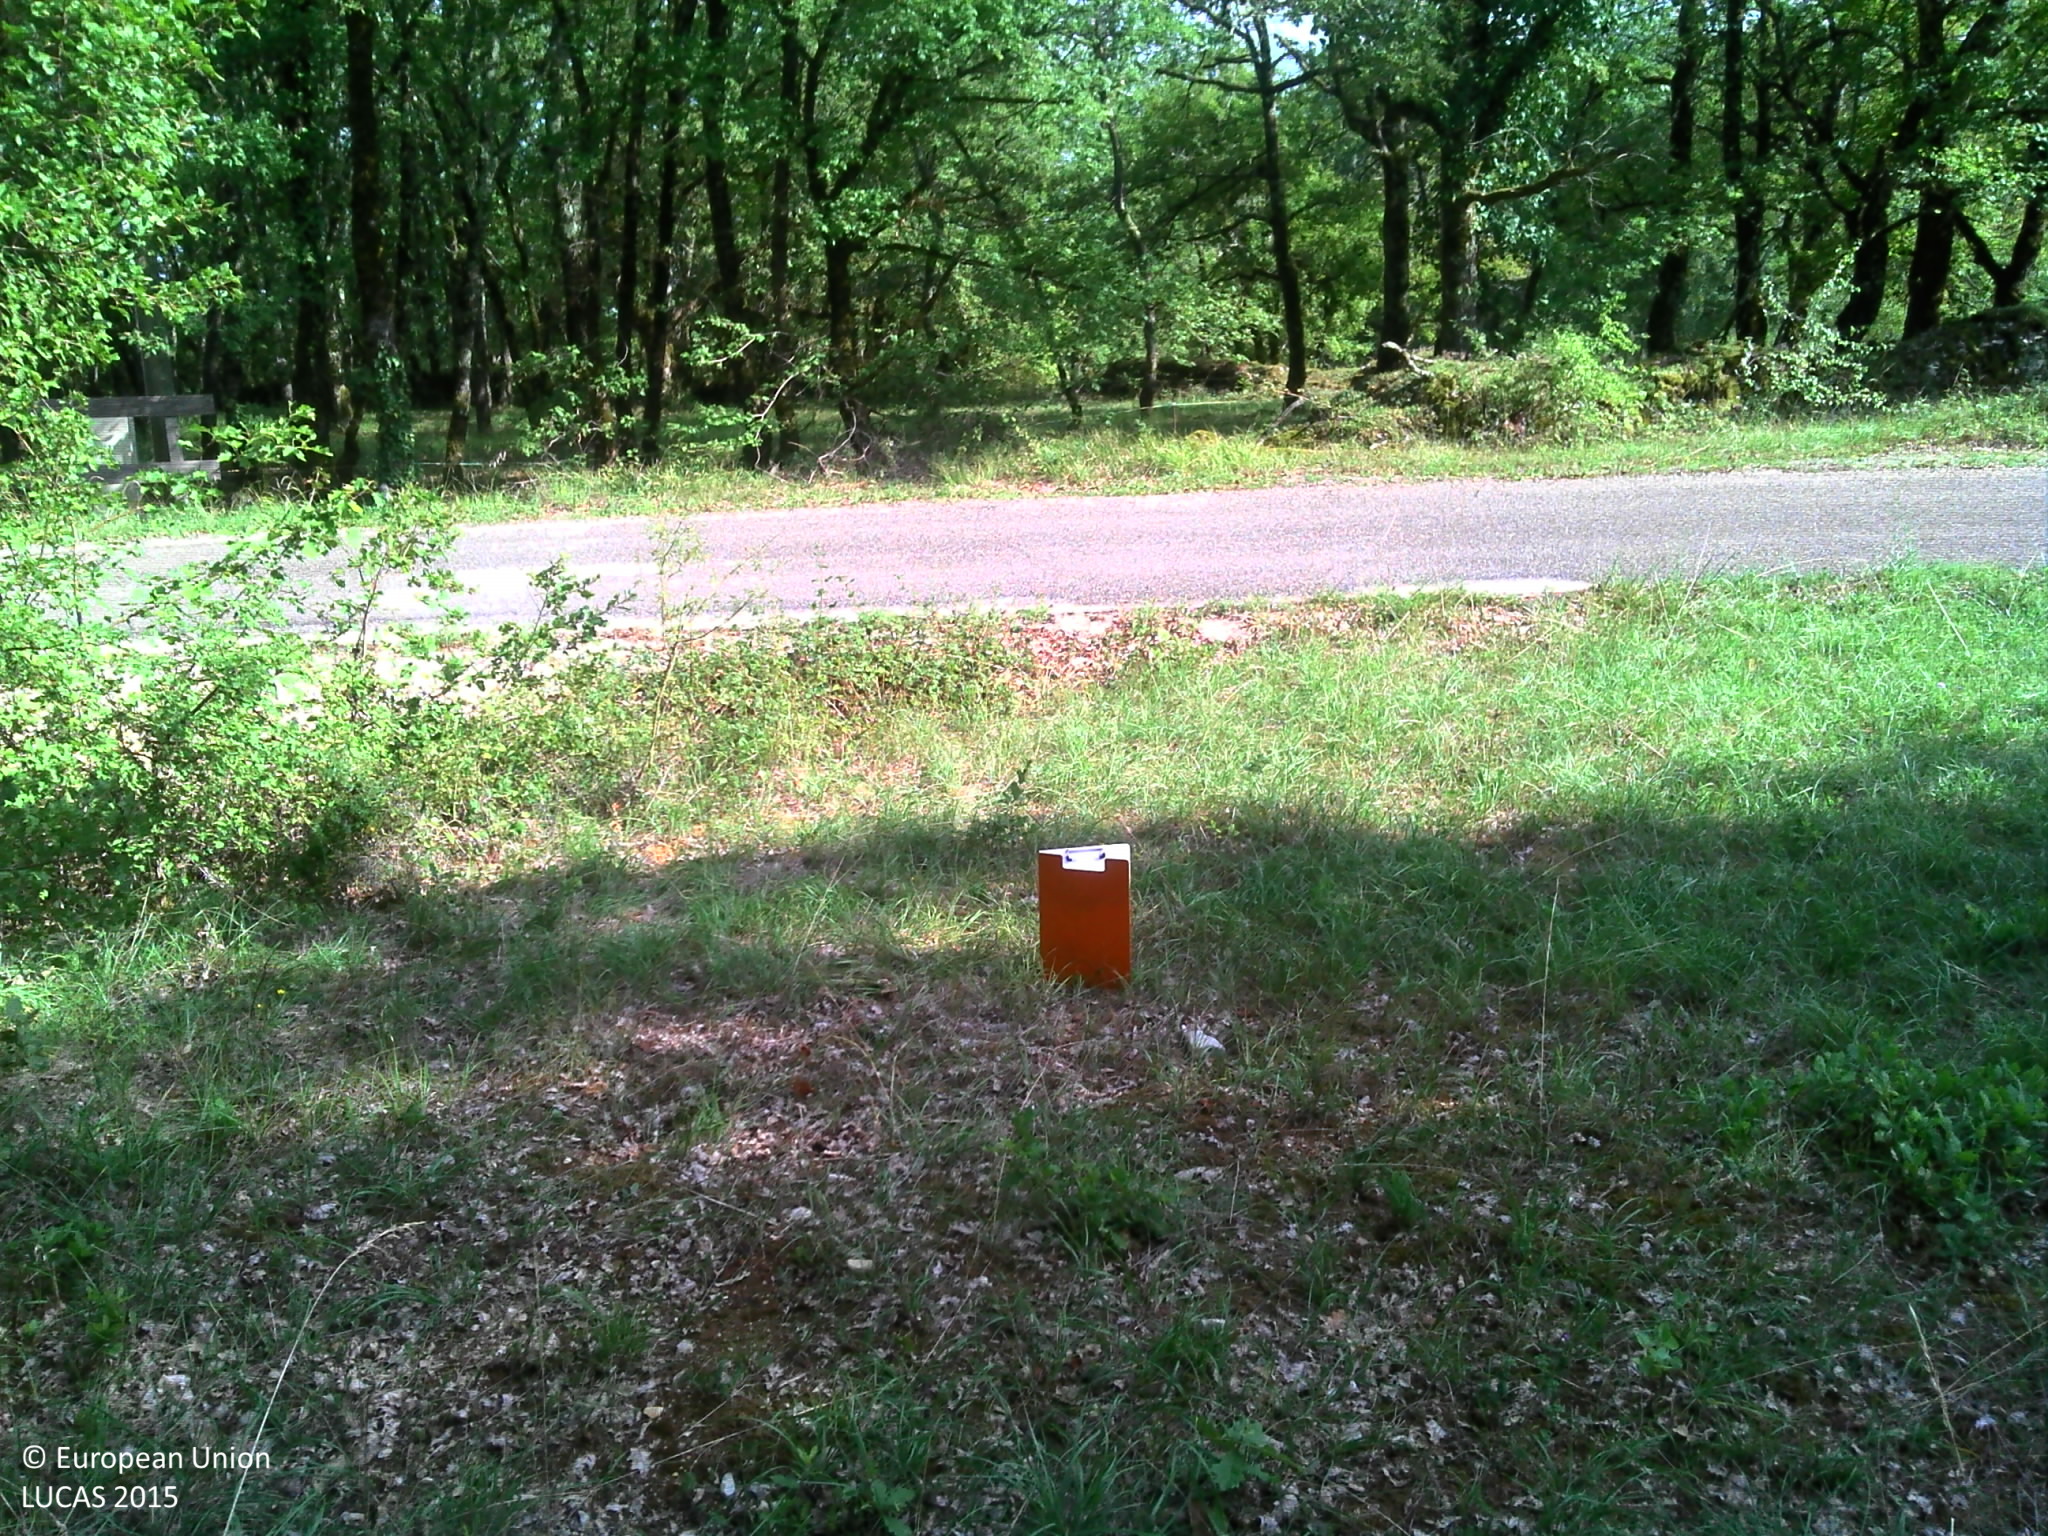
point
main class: Grassland
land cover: Grassland with sparse tree/shrub cover
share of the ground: > 75 %
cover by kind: herbaceous plants 90 %, broadleaved forest trees 5 %, shrubs 5 %
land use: Agriculture (excluding fallow land and kitchen gardens)
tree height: > 5 m
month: August
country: FR
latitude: 44.5087
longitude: 1.2799
